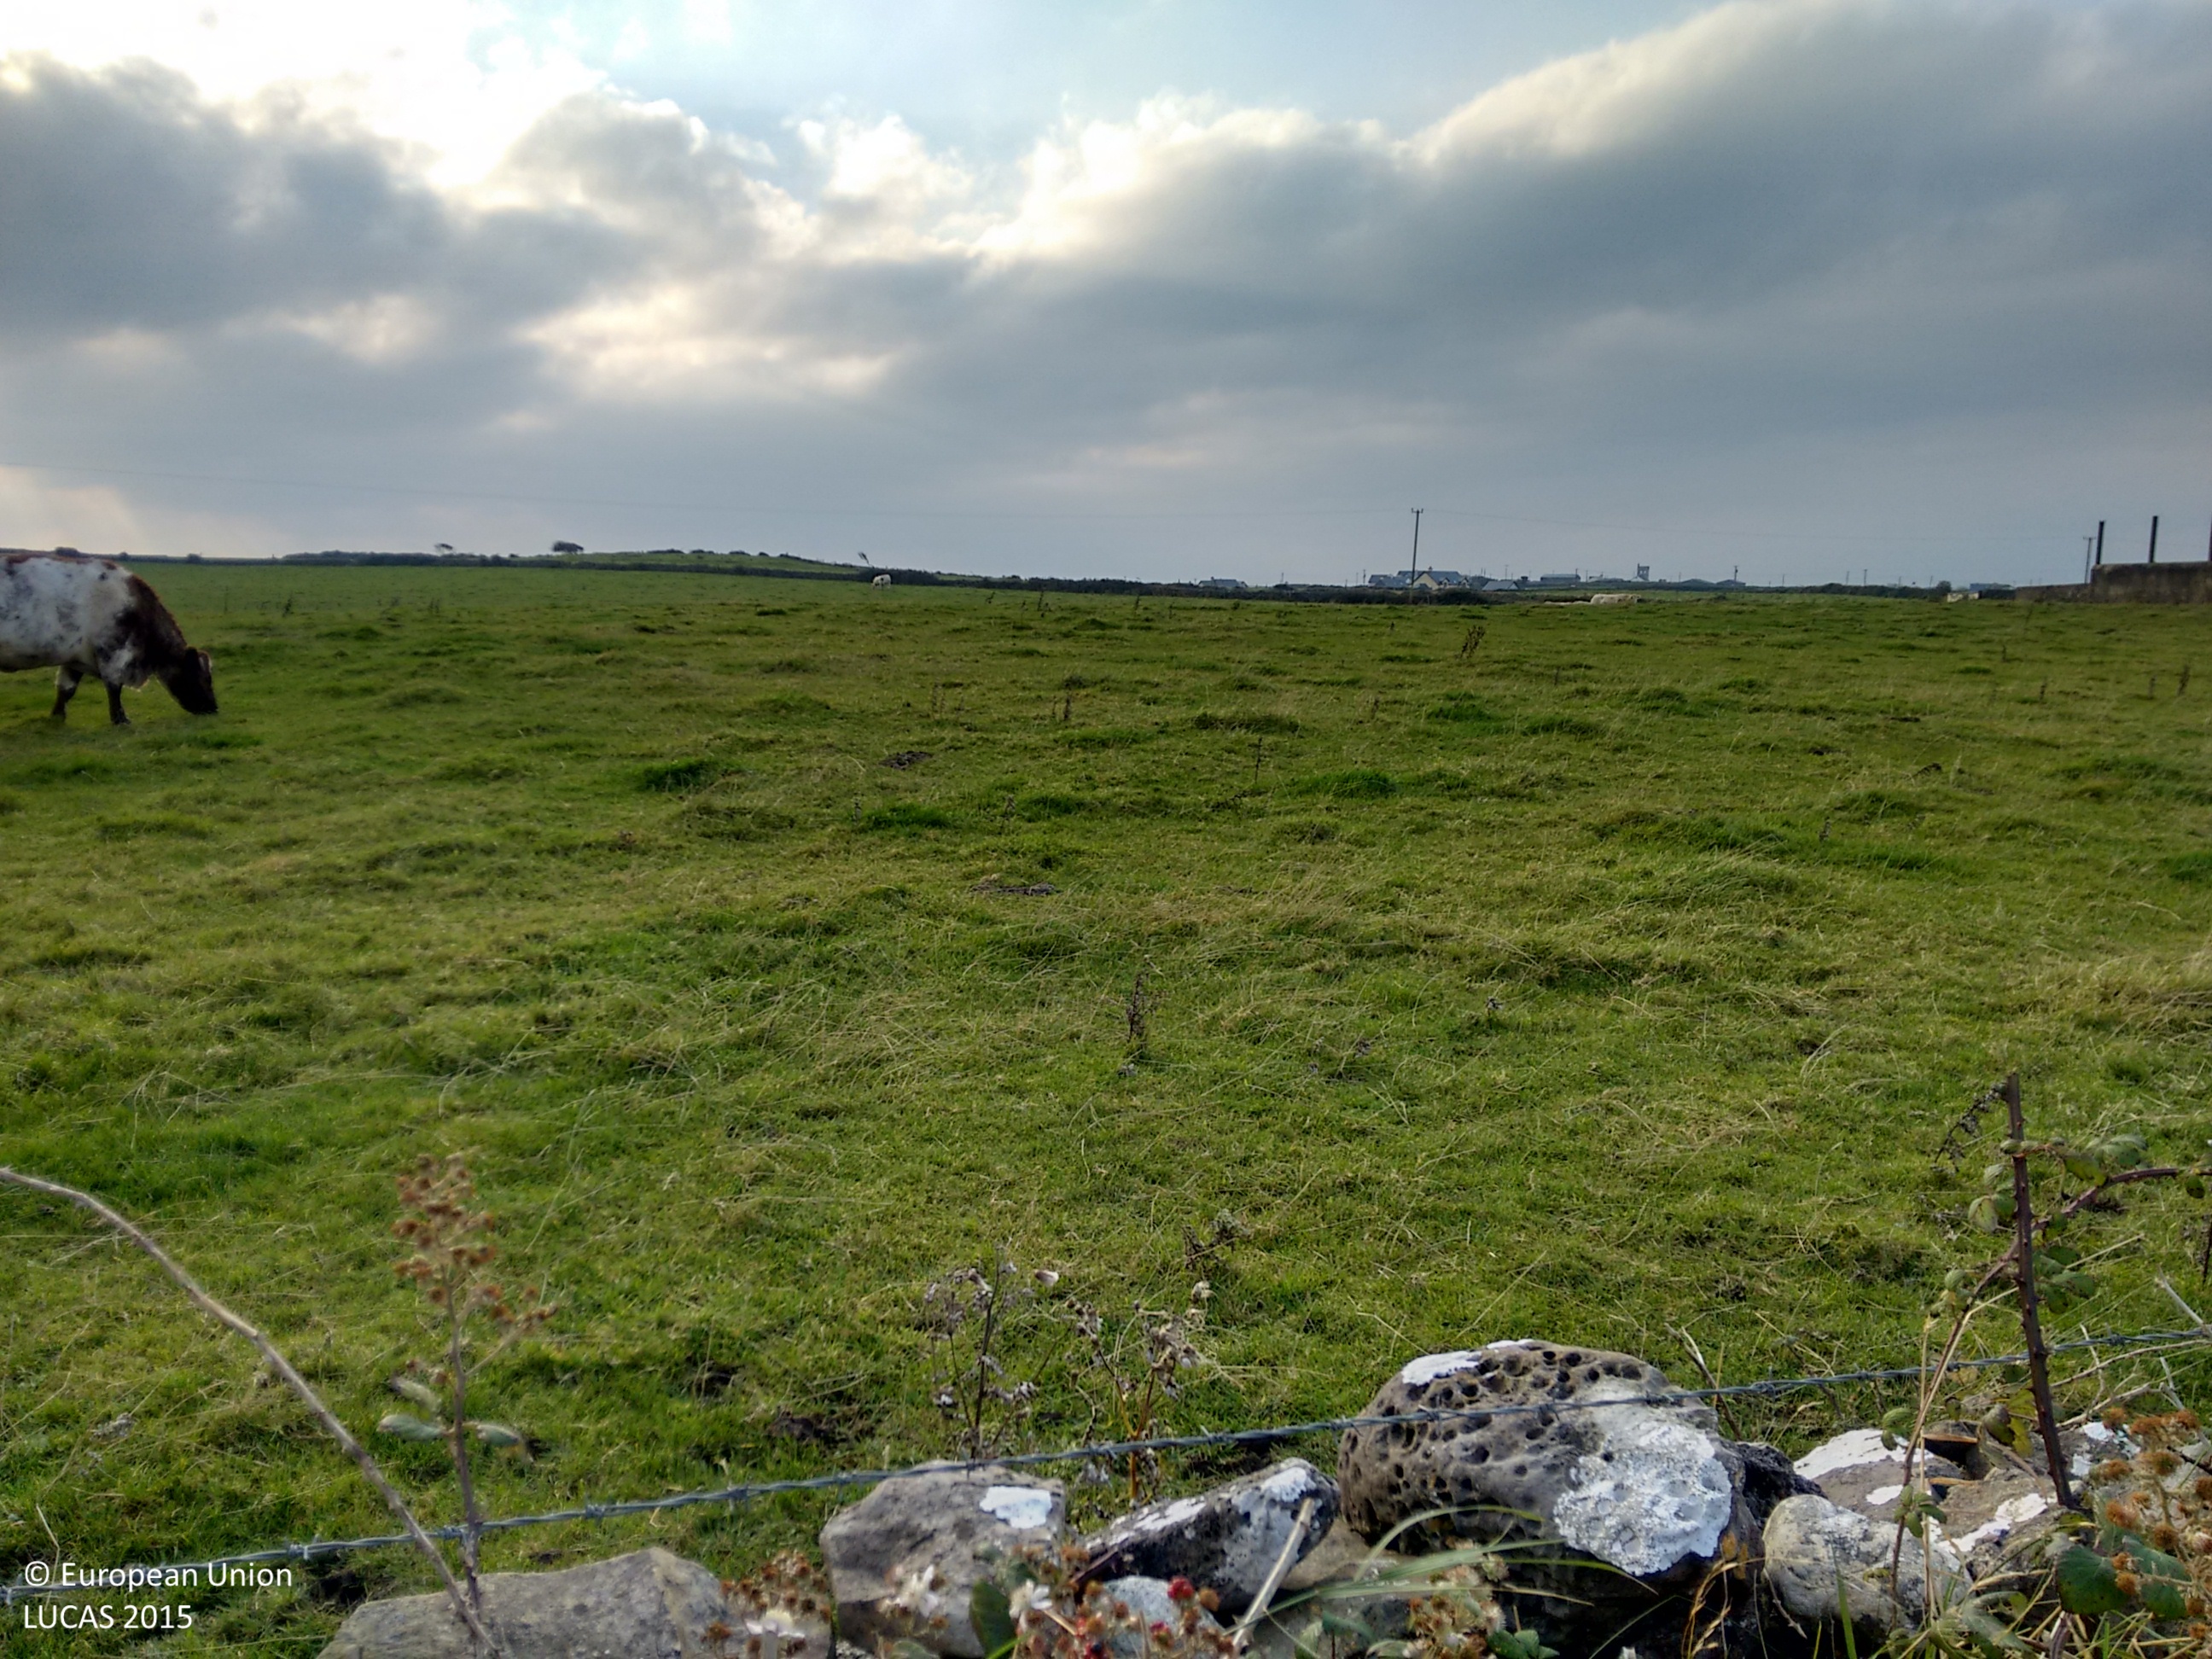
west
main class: Grassland
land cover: Grassland without tree/shrub cover
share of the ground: > 75 %
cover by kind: herbaceous plants 100 %
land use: Agriculture (excluding fallow land and kitchen gardens)
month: November
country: IE
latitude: 54.2794
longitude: -9.0264
